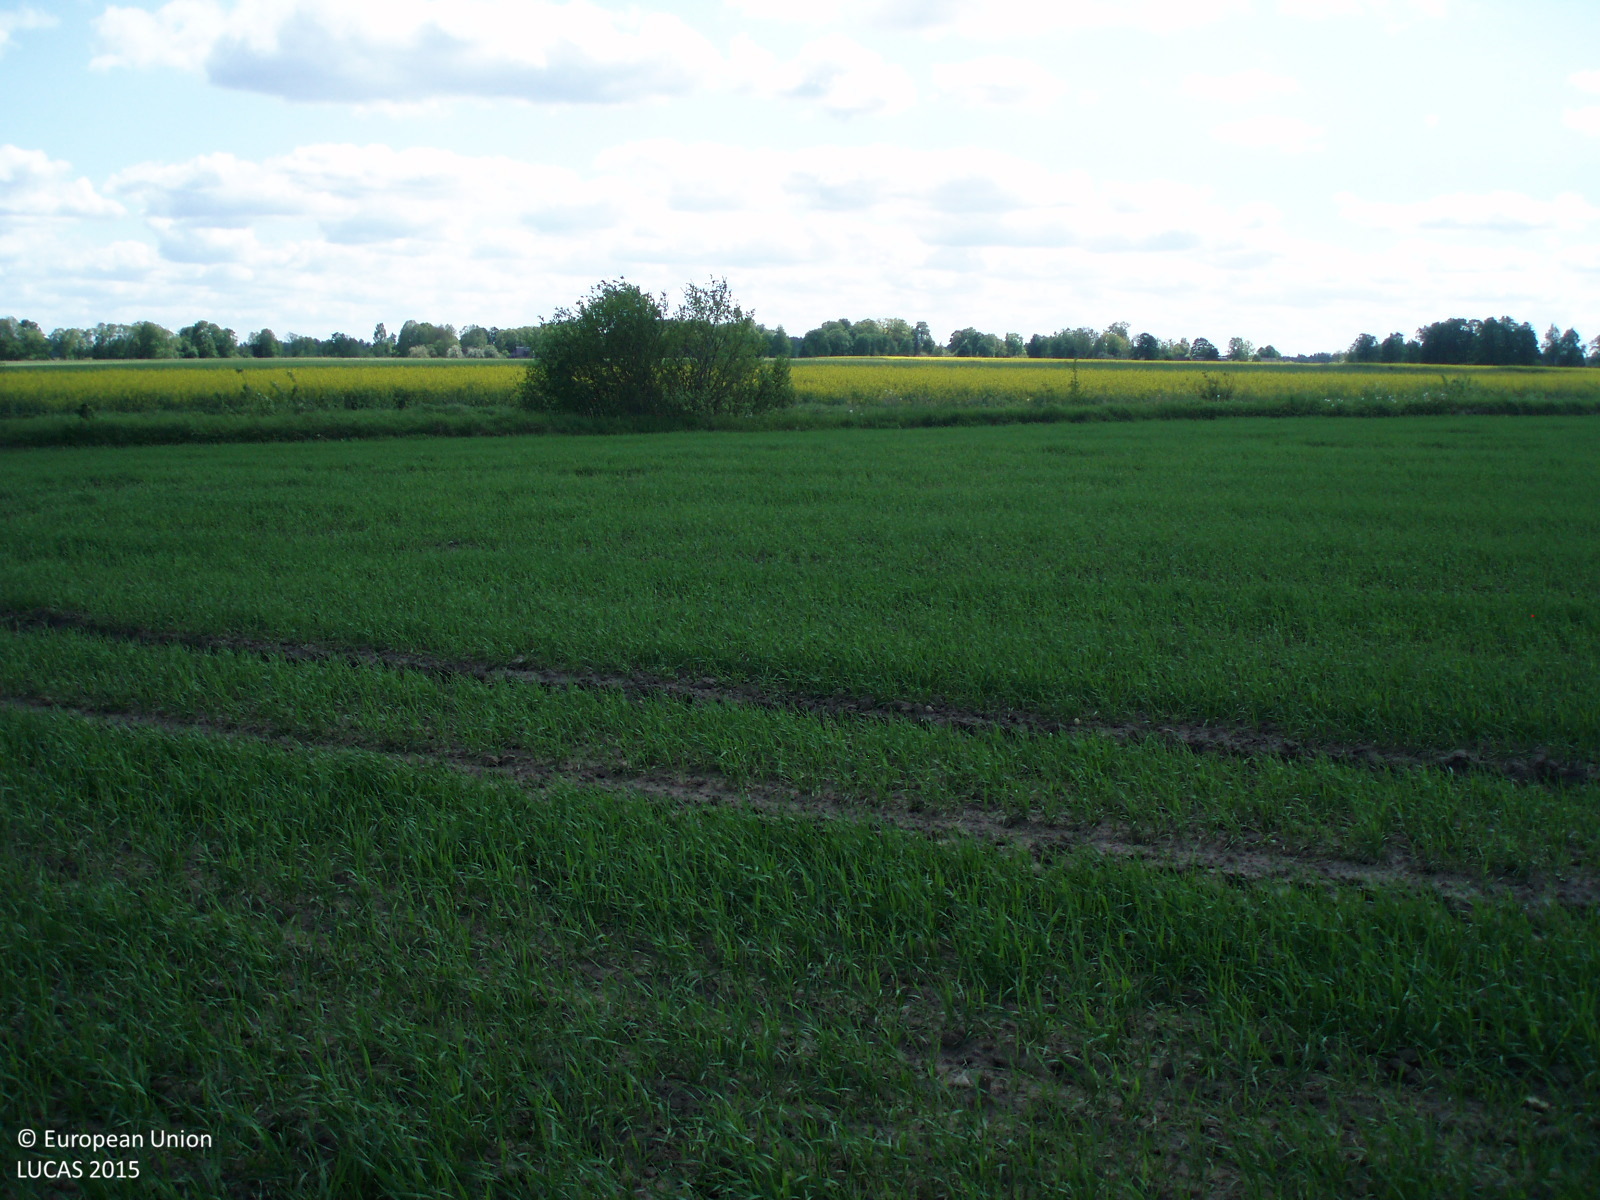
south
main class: Cropland
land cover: Common wheat
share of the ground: > 75 %
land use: Agriculture (excluding fallow land and kitchen gardens)
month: May
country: LT
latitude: 56.1405
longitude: 22.6624
